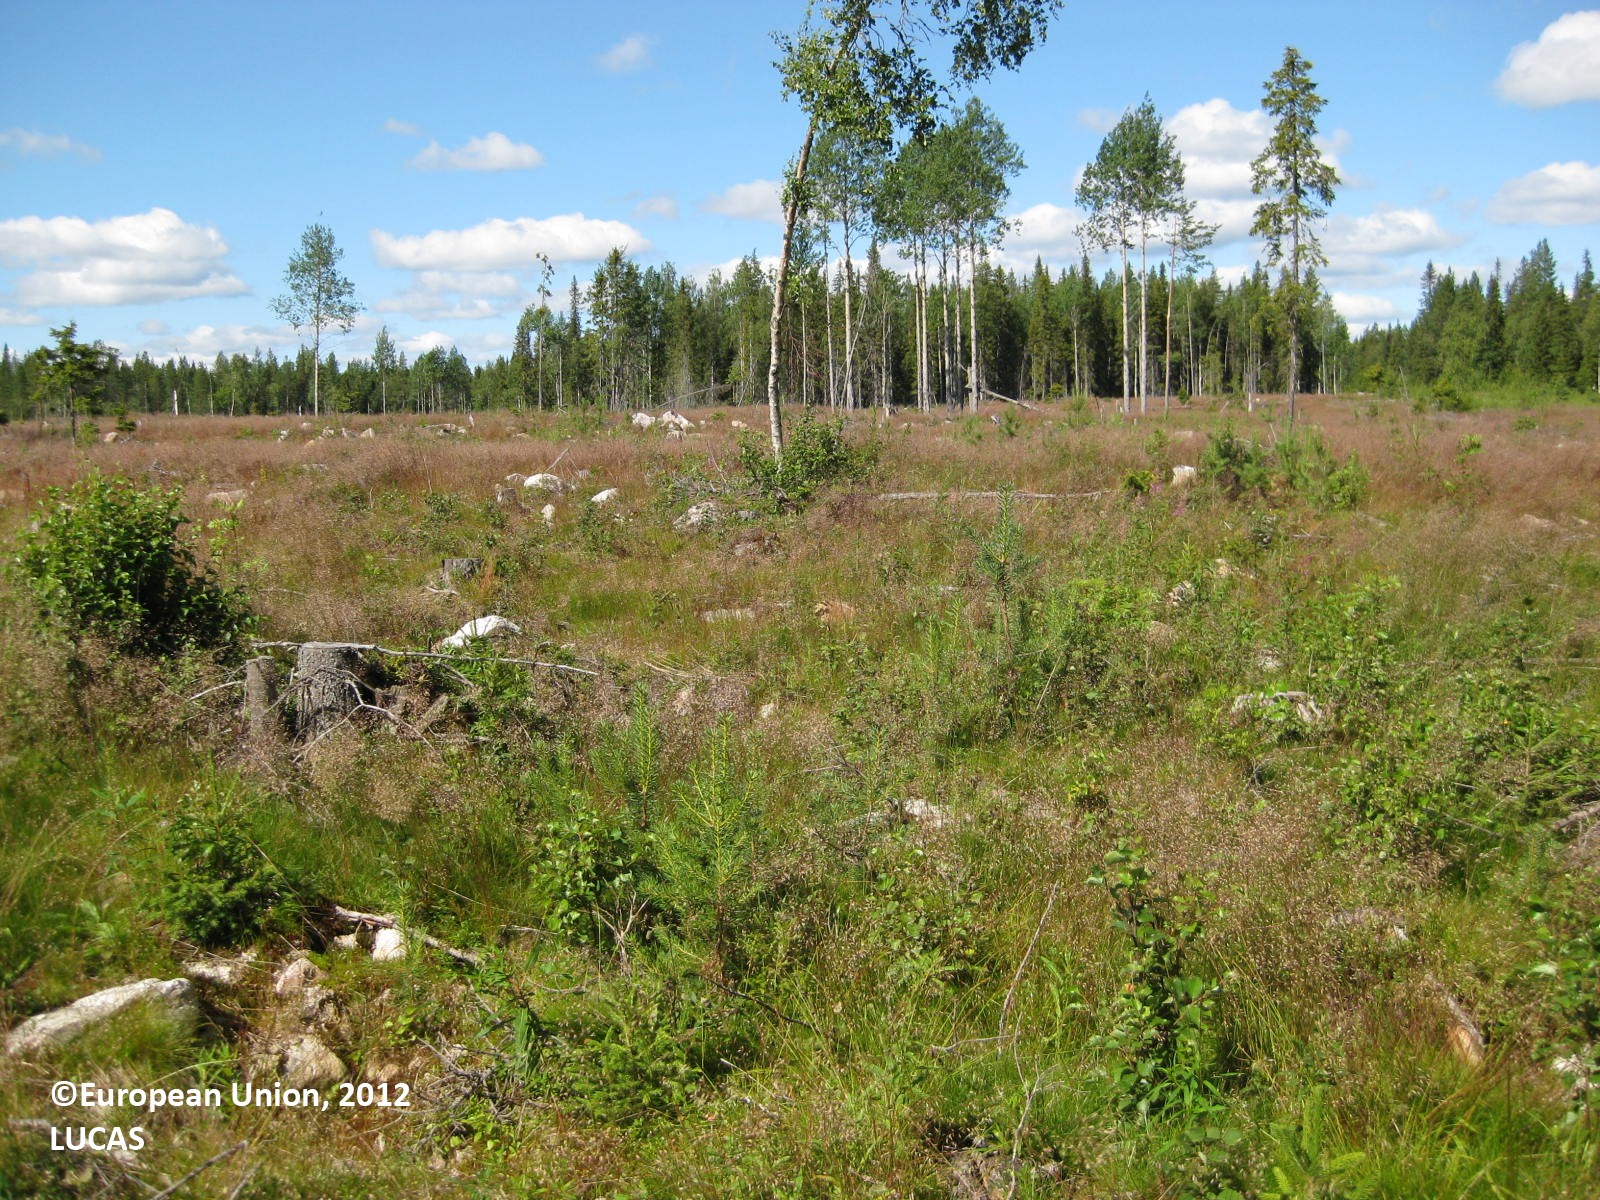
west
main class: Grassland
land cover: Grassland with sparse tree/shrub cover
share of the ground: > 75 %
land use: Forestry
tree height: < 5 m
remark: Clear cut
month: July
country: FI
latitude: 65.6830
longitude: 28.3705
